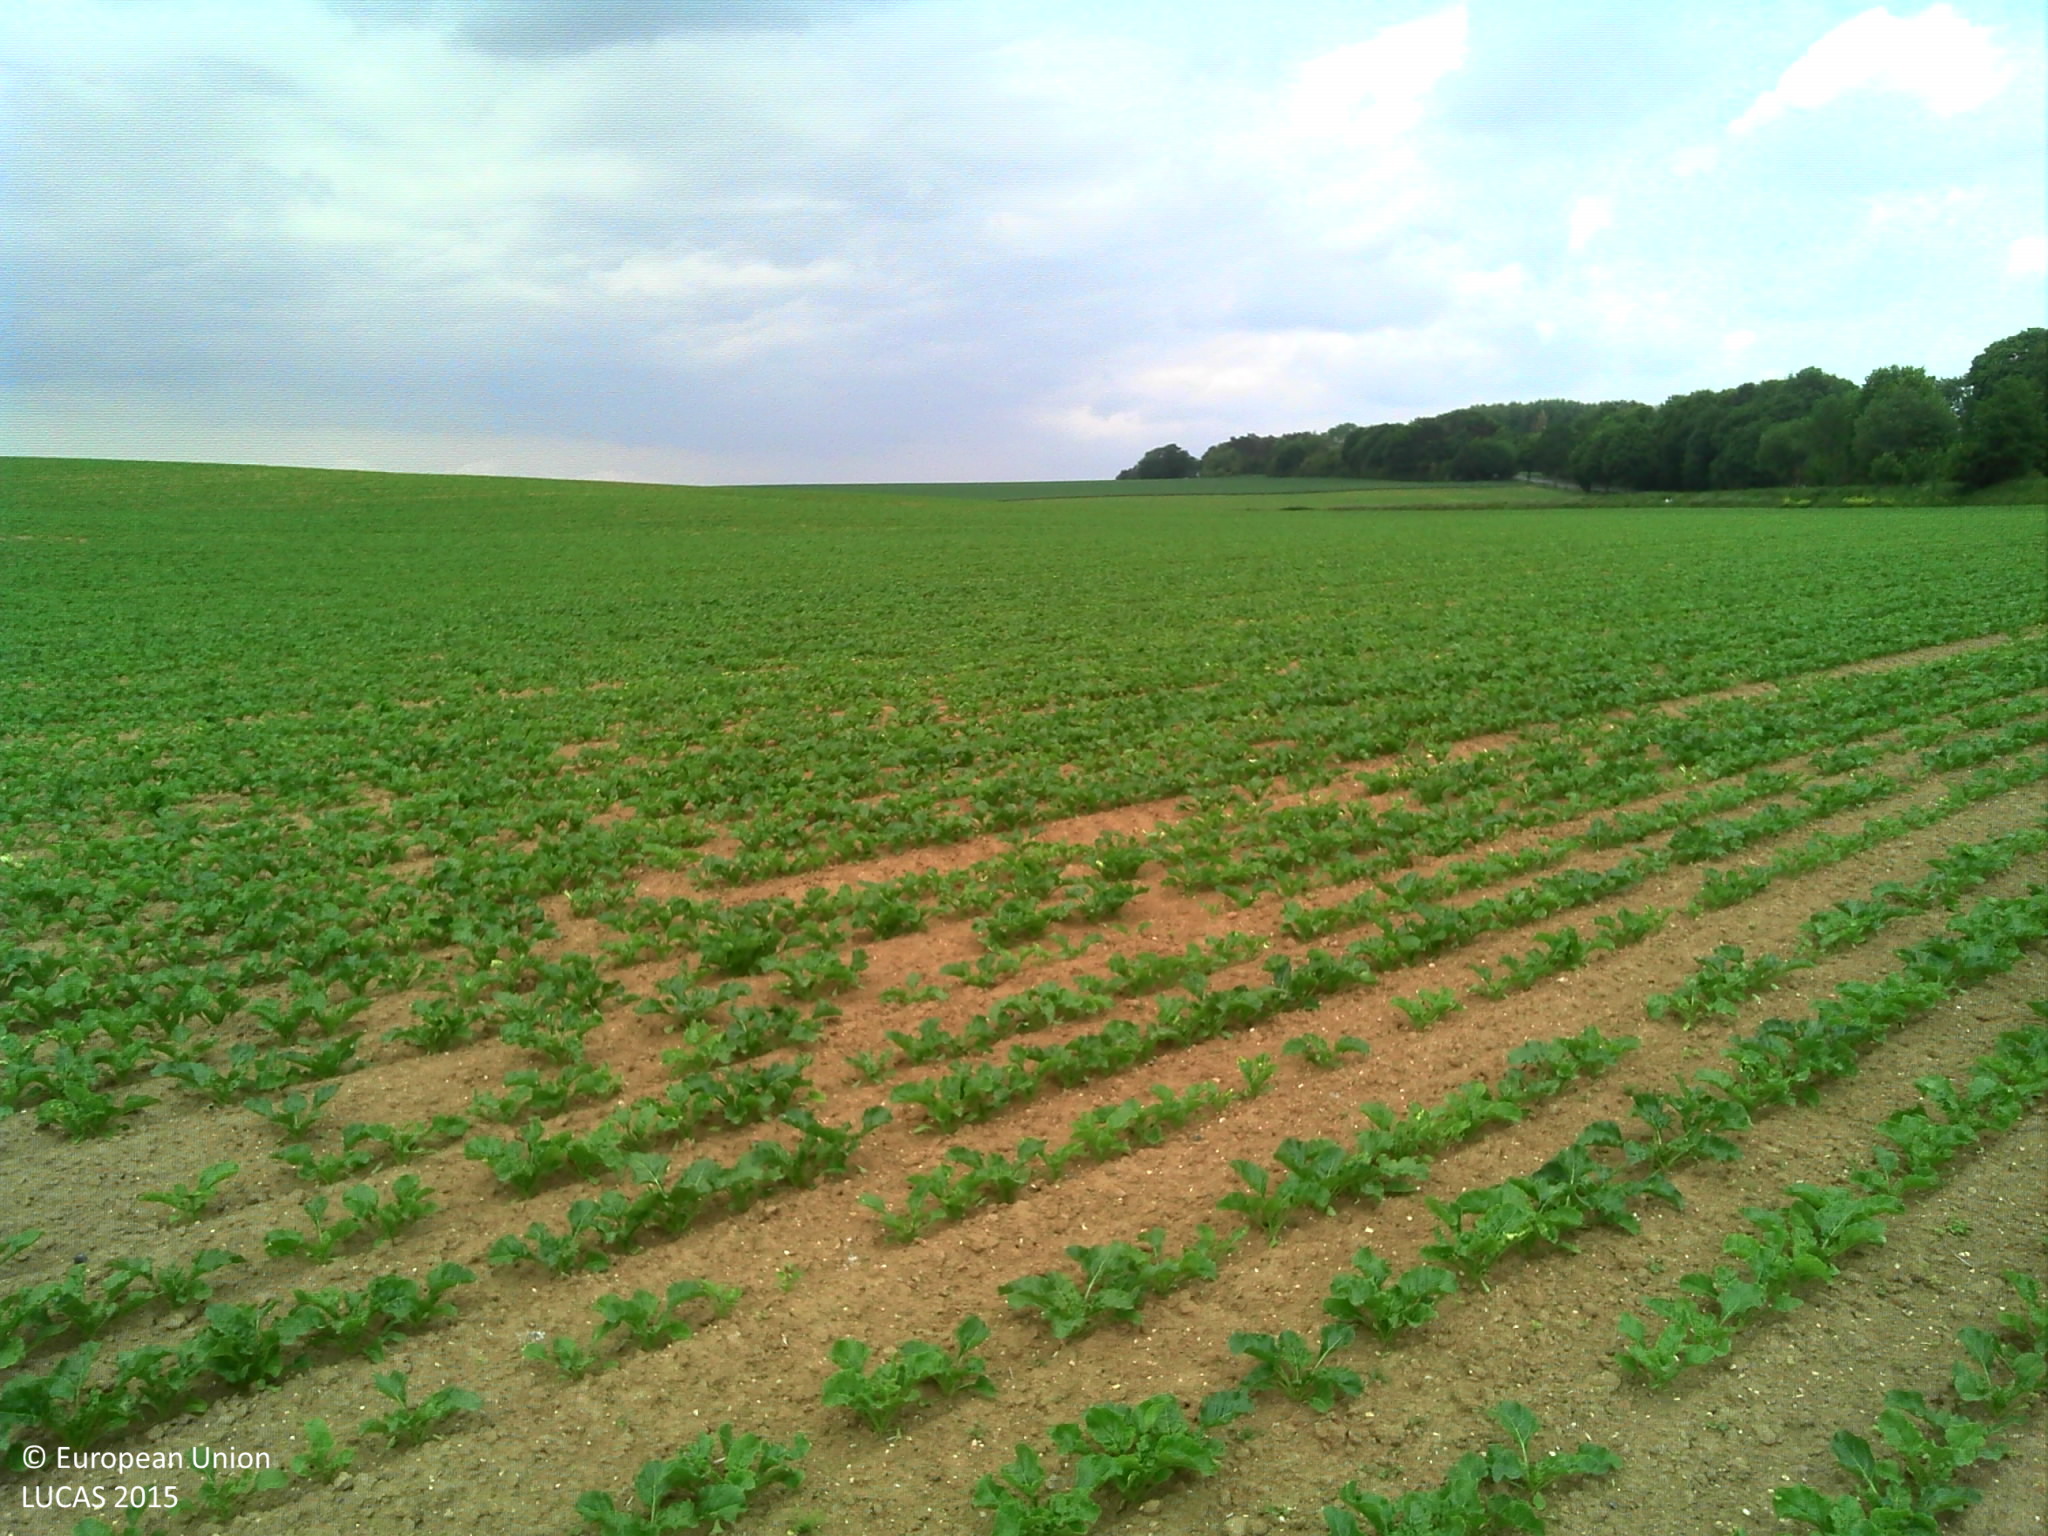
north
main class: Cropland
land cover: Sugar beet
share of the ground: > 75 %
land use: Agriculture (excluding fallow land and kitchen gardens)
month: May
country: FR
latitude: 49.9649
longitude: 3.2300
